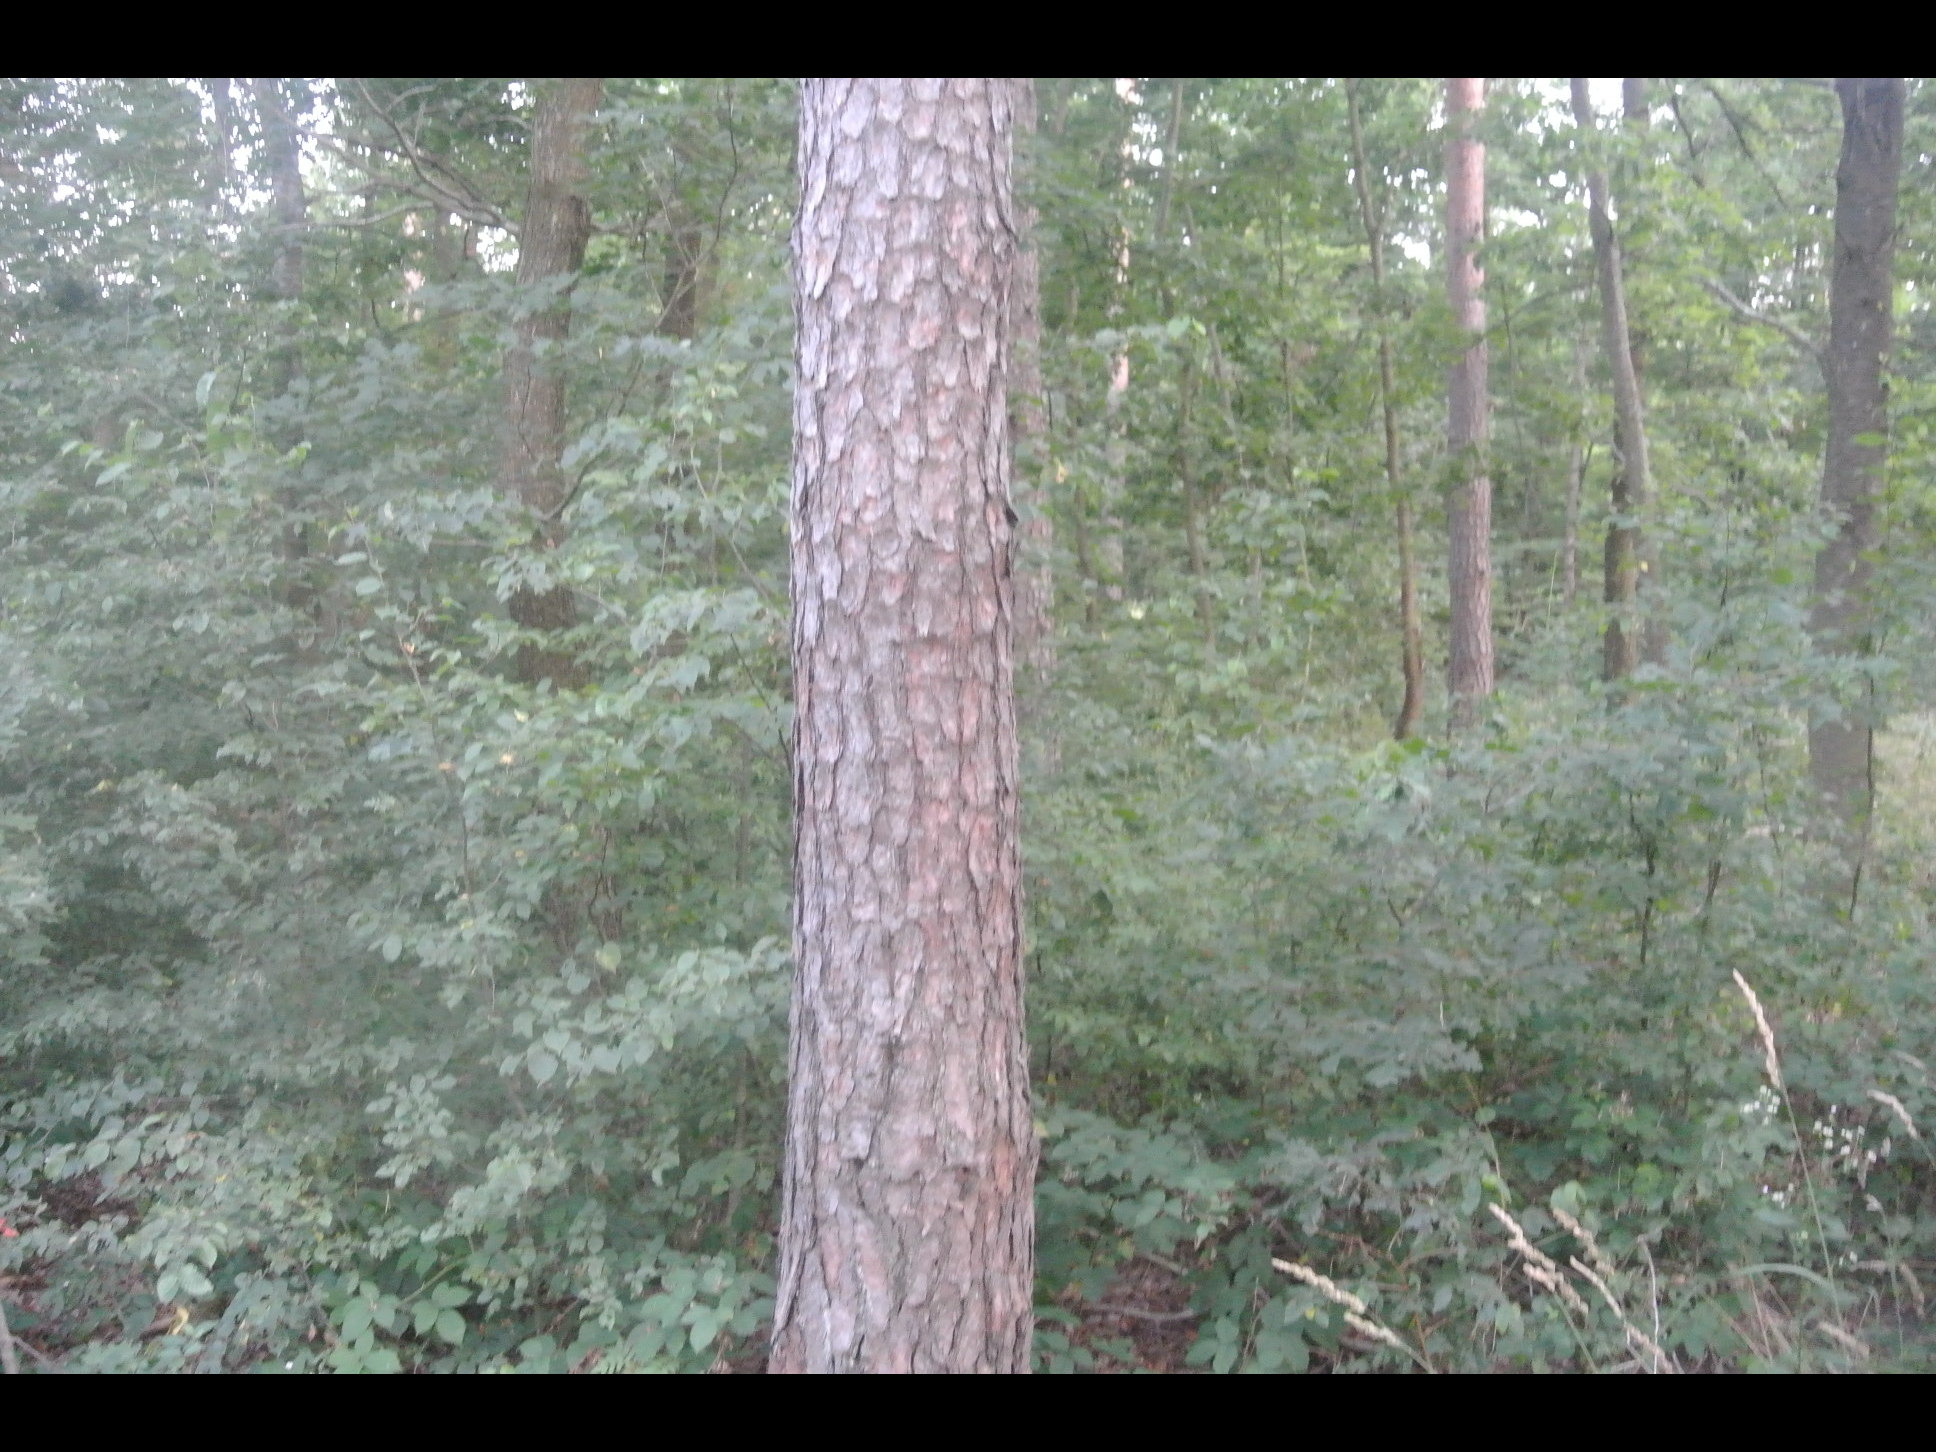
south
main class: Woodland
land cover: Pine dominated mixed woodland
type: alpine coniferous forest
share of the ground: > 75 %
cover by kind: broadleaved forest trees 75 %, coniferous forest trees 25 %
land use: Forestry
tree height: > 5 m
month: July
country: AT
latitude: 47.5832
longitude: 16.4525
